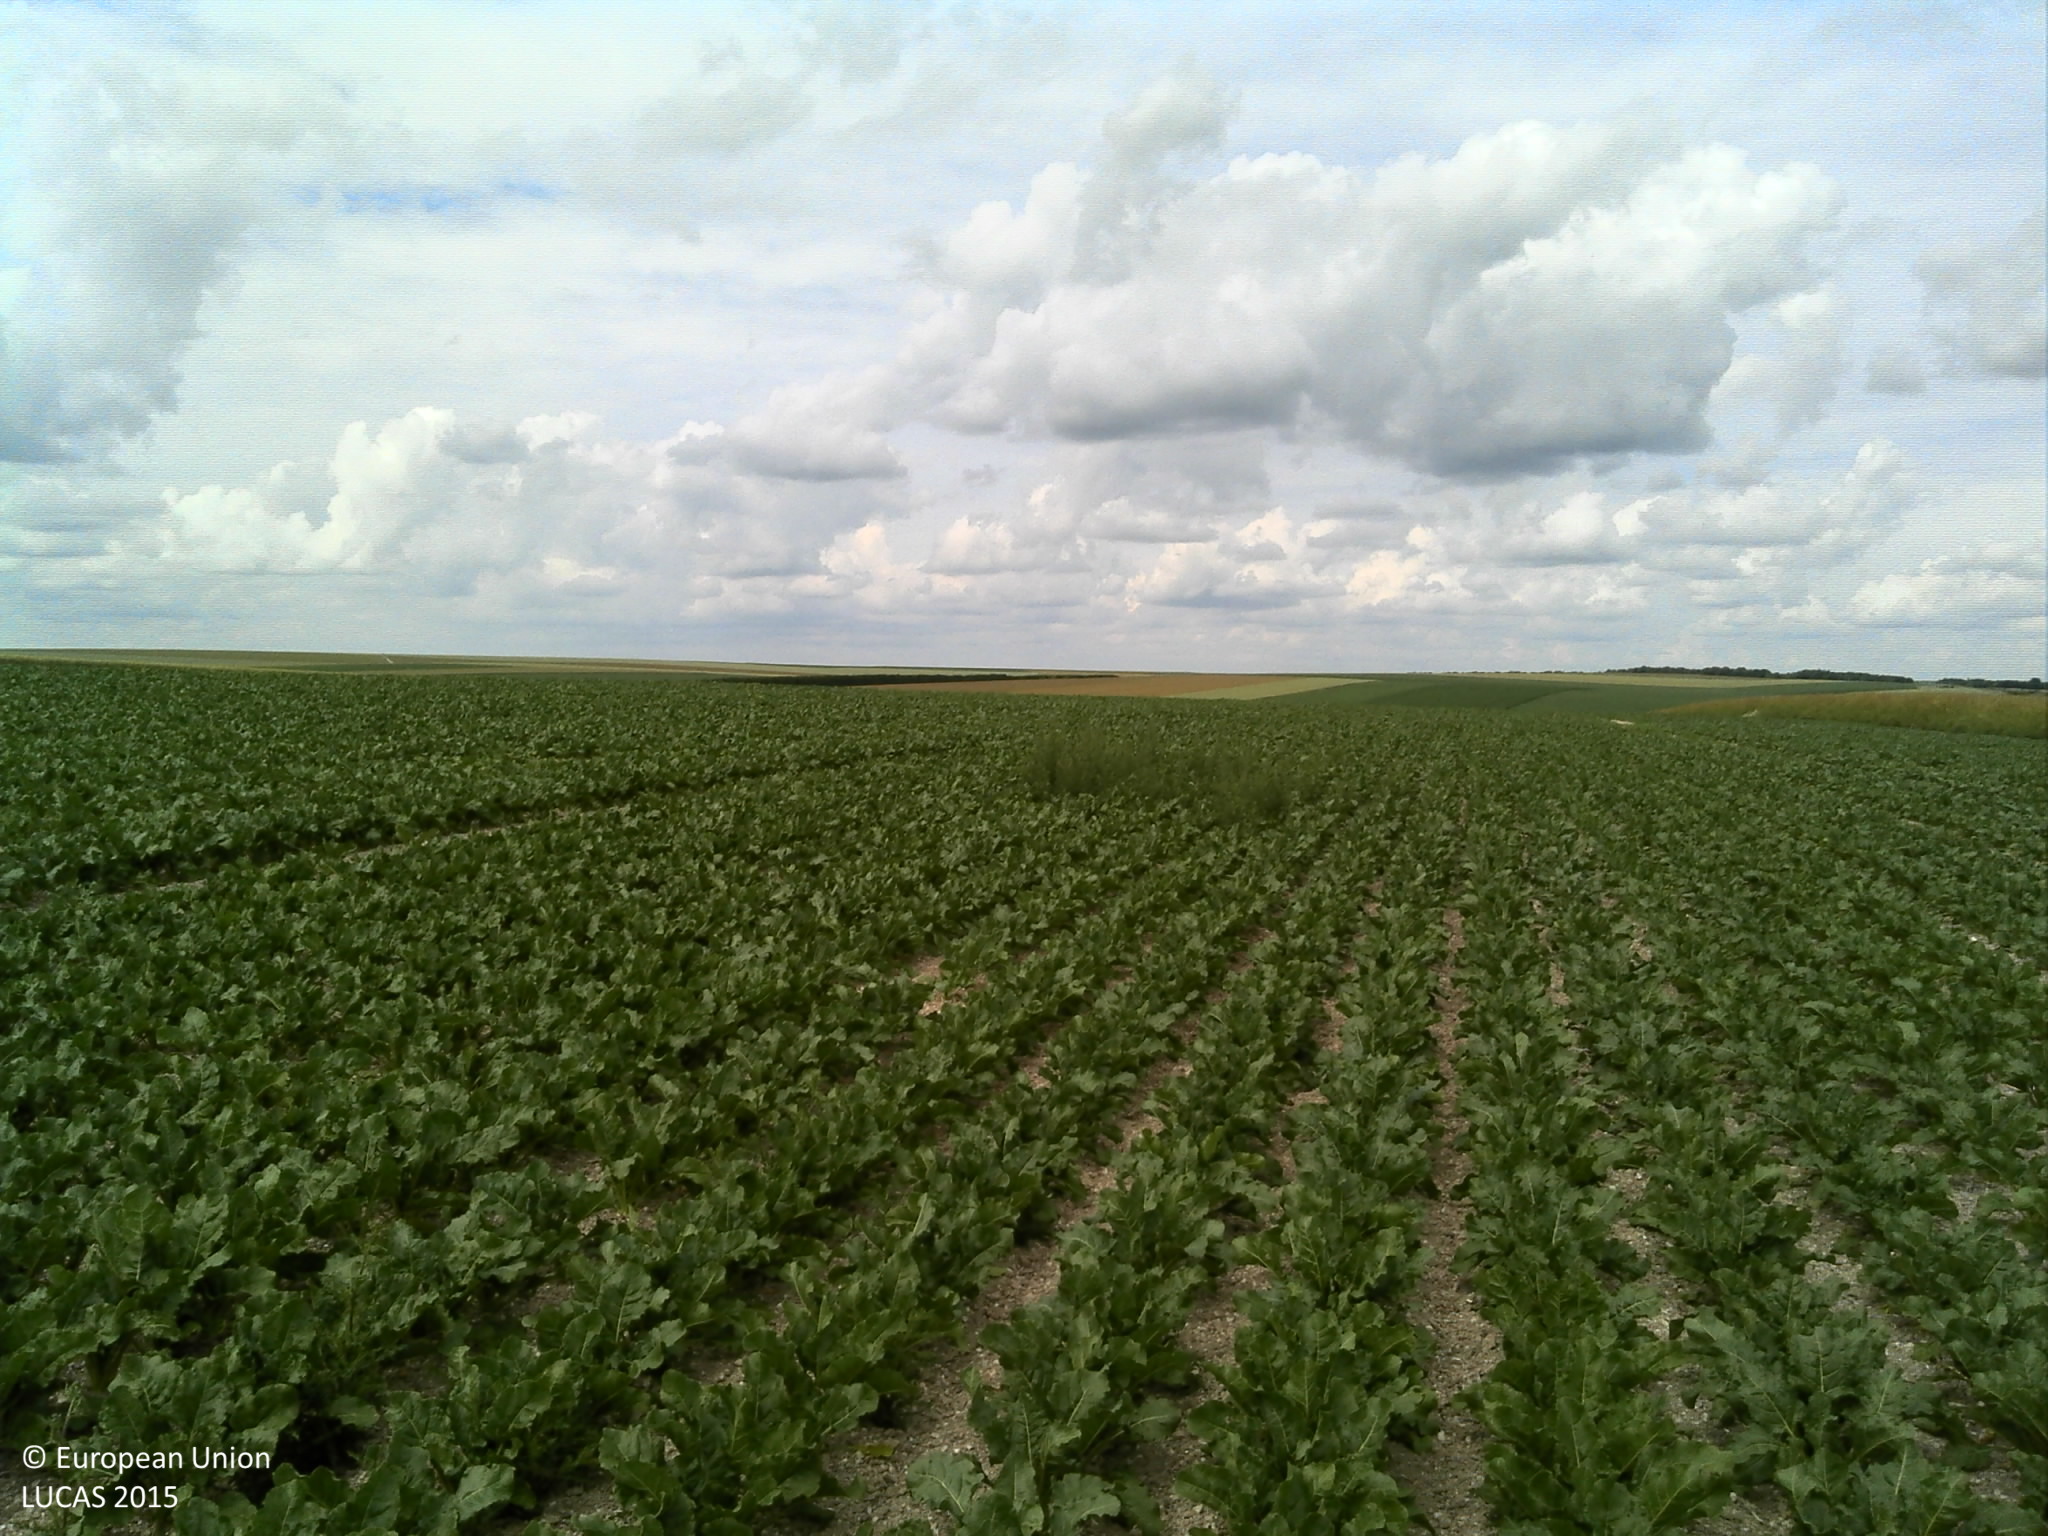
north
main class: Cropland
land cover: Sugar beet
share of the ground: 50 - 75 %
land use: Agriculture (excluding fallow land and kitchen gardens)
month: June
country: FR
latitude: 48.6826
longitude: 4.1691
